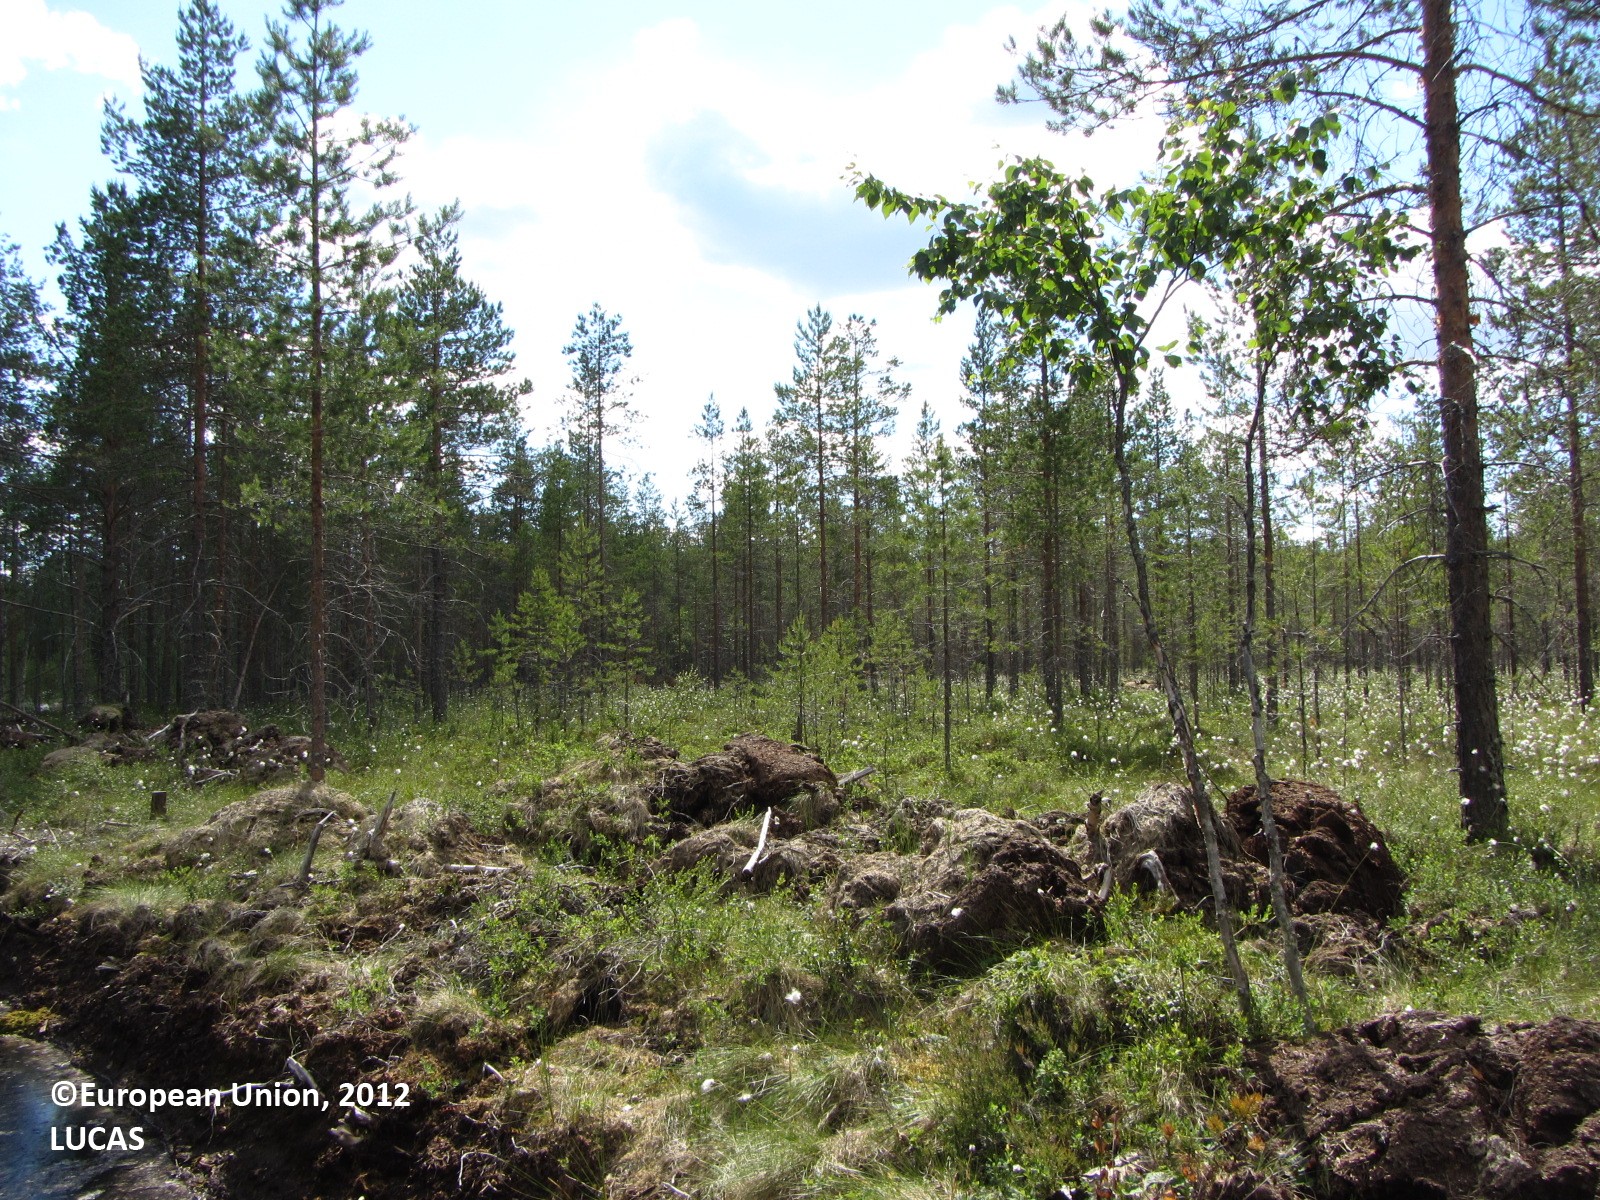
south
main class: Woodland
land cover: Pine dominated coniferous woodland
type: boreal forest
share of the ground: 50 - 75 %
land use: Forestry
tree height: > 5 m
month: July
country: FI
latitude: 63.2582
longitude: 25.3388
